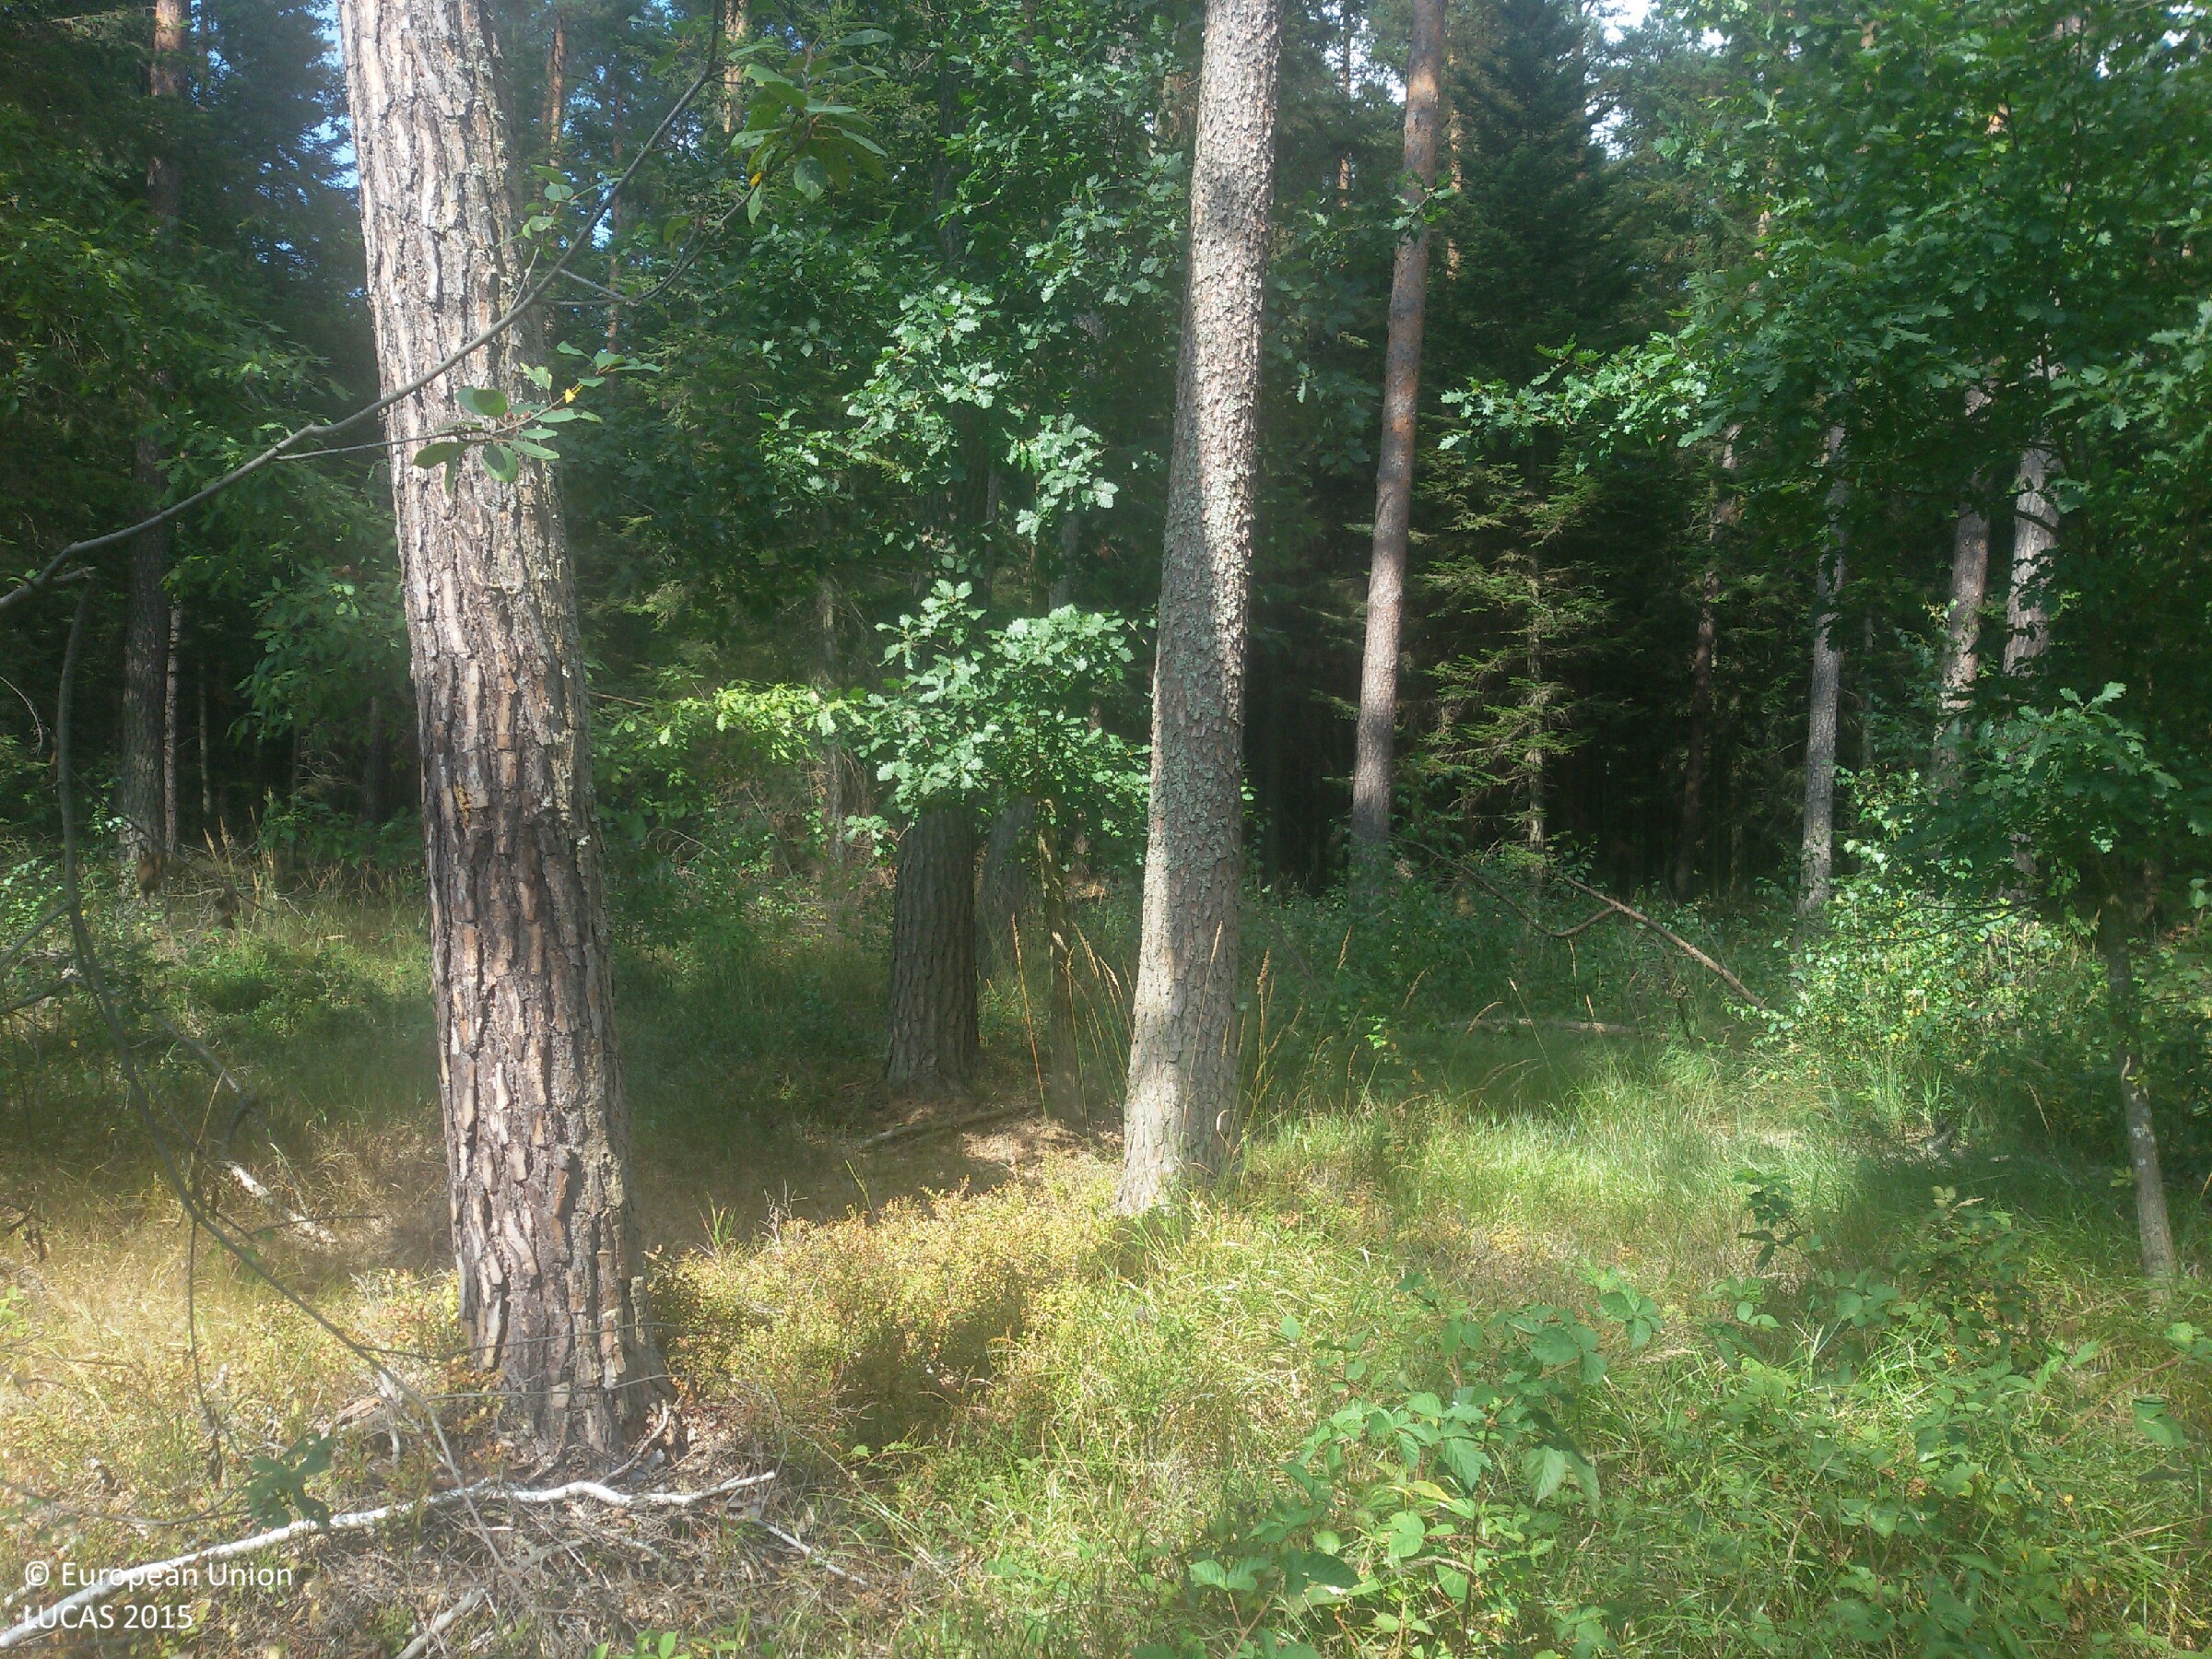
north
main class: Woodland
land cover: Pine dominated mixed woodland
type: hemiboreal forest and nemoral coniferous forest and mixed broadleaved-coniferous forest
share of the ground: > 75 %
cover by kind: coniferous forest trees 60 %, broadleaved forest trees 25 %, herbaceous plants 10 %, shrubs 5 %
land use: Forestry
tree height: > 5 m
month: September
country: PL
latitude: 50.9987
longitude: 20.9444
